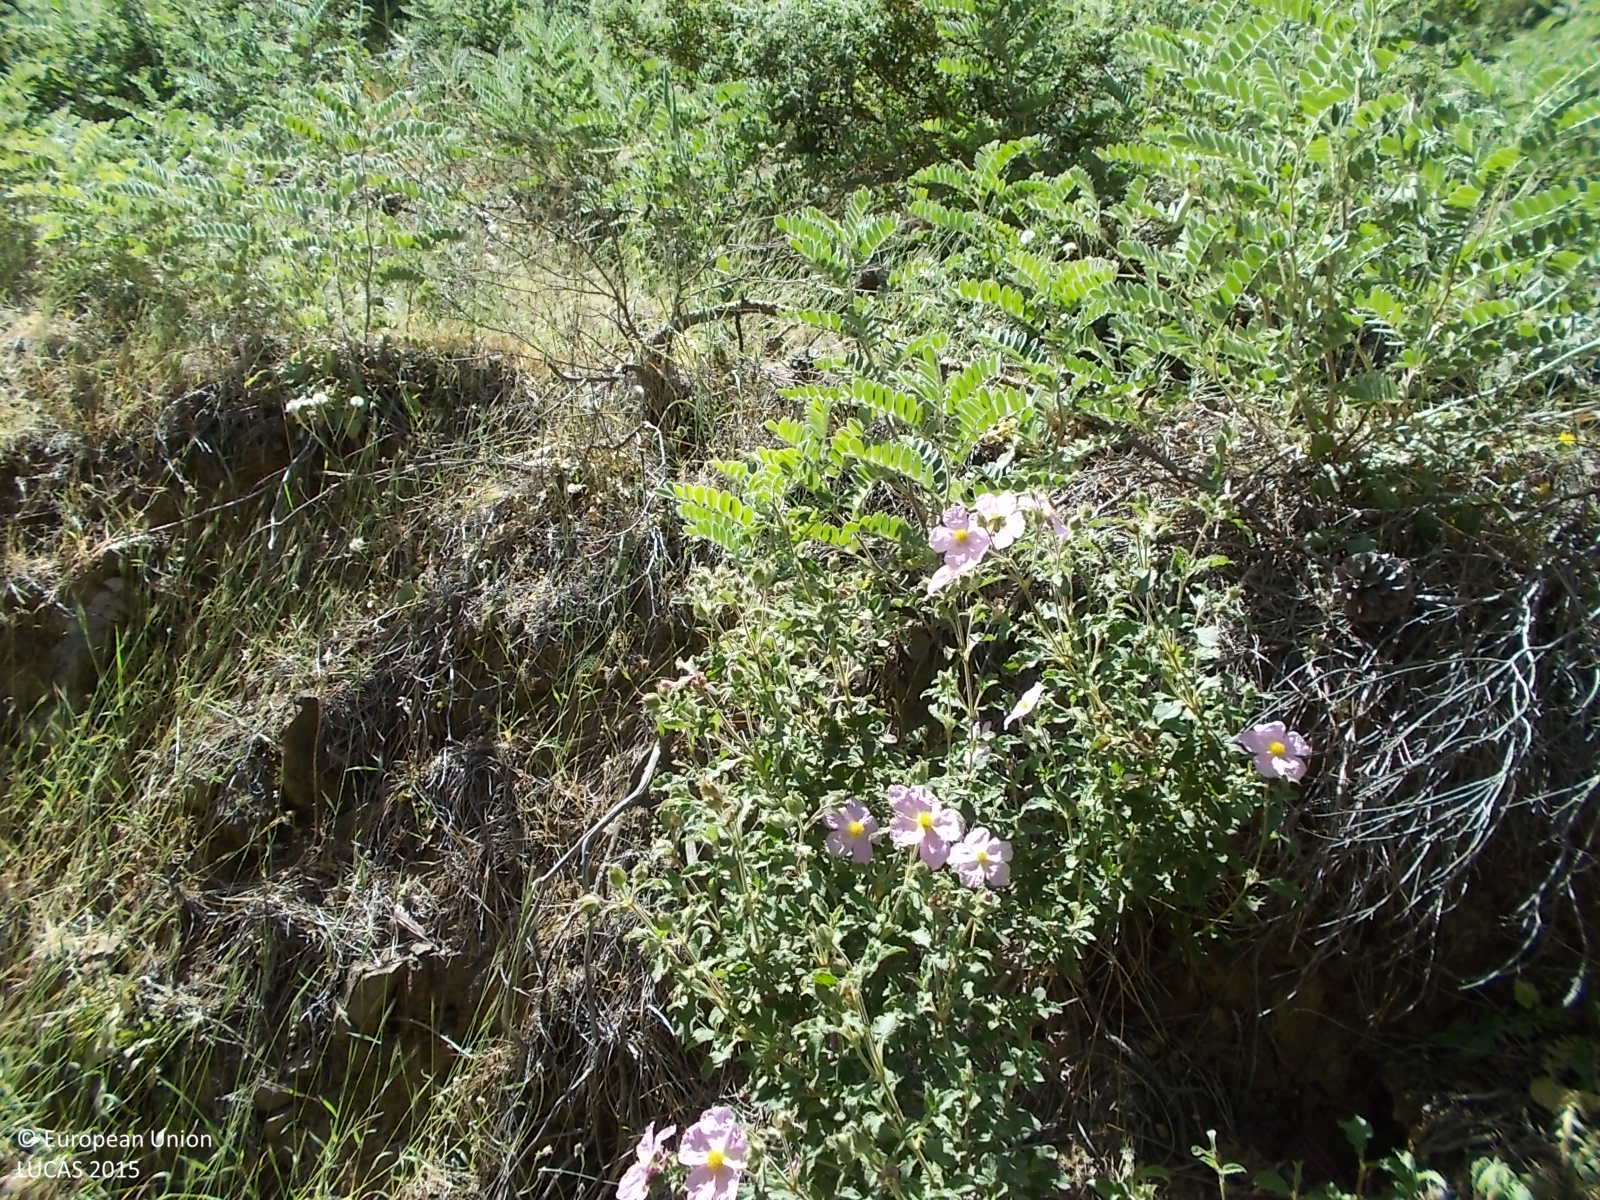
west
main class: Woodland
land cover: Pine dominated coniferous woodland
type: coniferous forest of the mediterranean region
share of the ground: > 75 %
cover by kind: coniferous forest trees 100 %
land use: Semi-natural and natural areas not in use
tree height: > 5 m
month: May
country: CY
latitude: 34.9470
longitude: 33.2075
